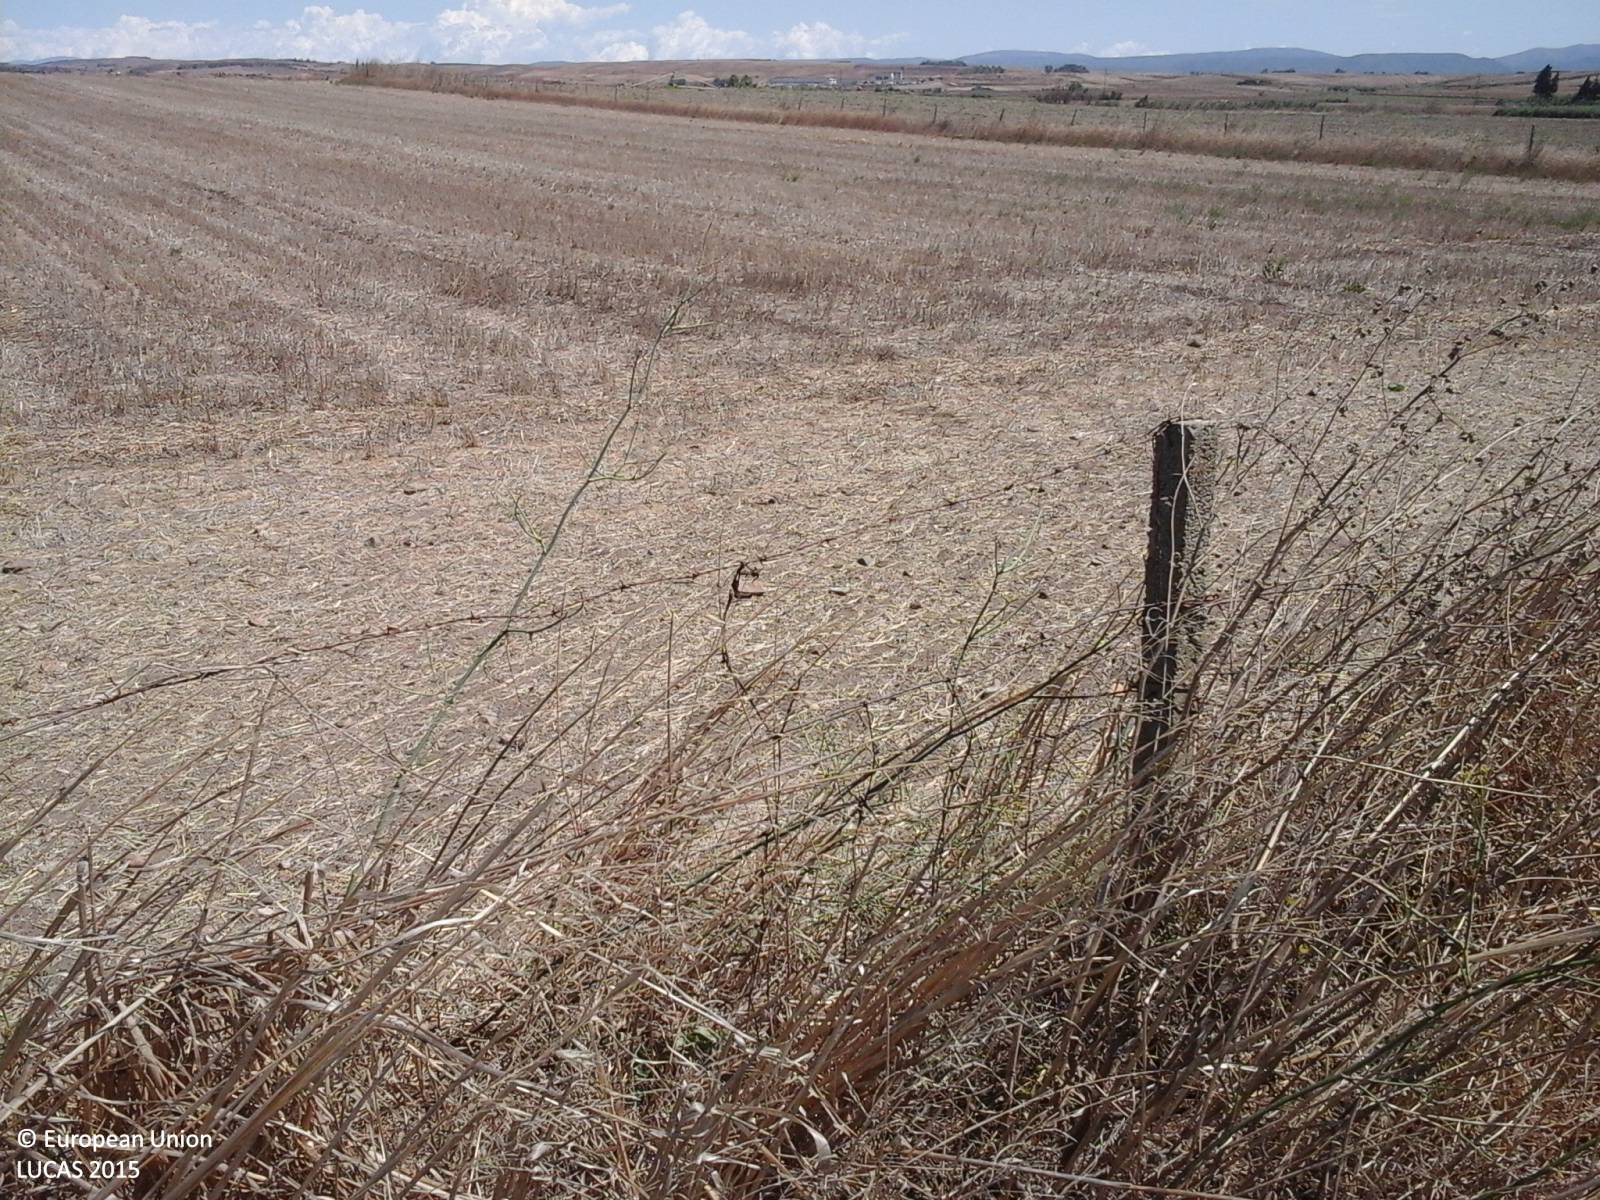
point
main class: Cropland
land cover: Durum wheat
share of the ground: > 75 %
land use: Agriculture (excluding fallow land and kitchen gardens)
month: August
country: IT
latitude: 39.4109
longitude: 8.9956
